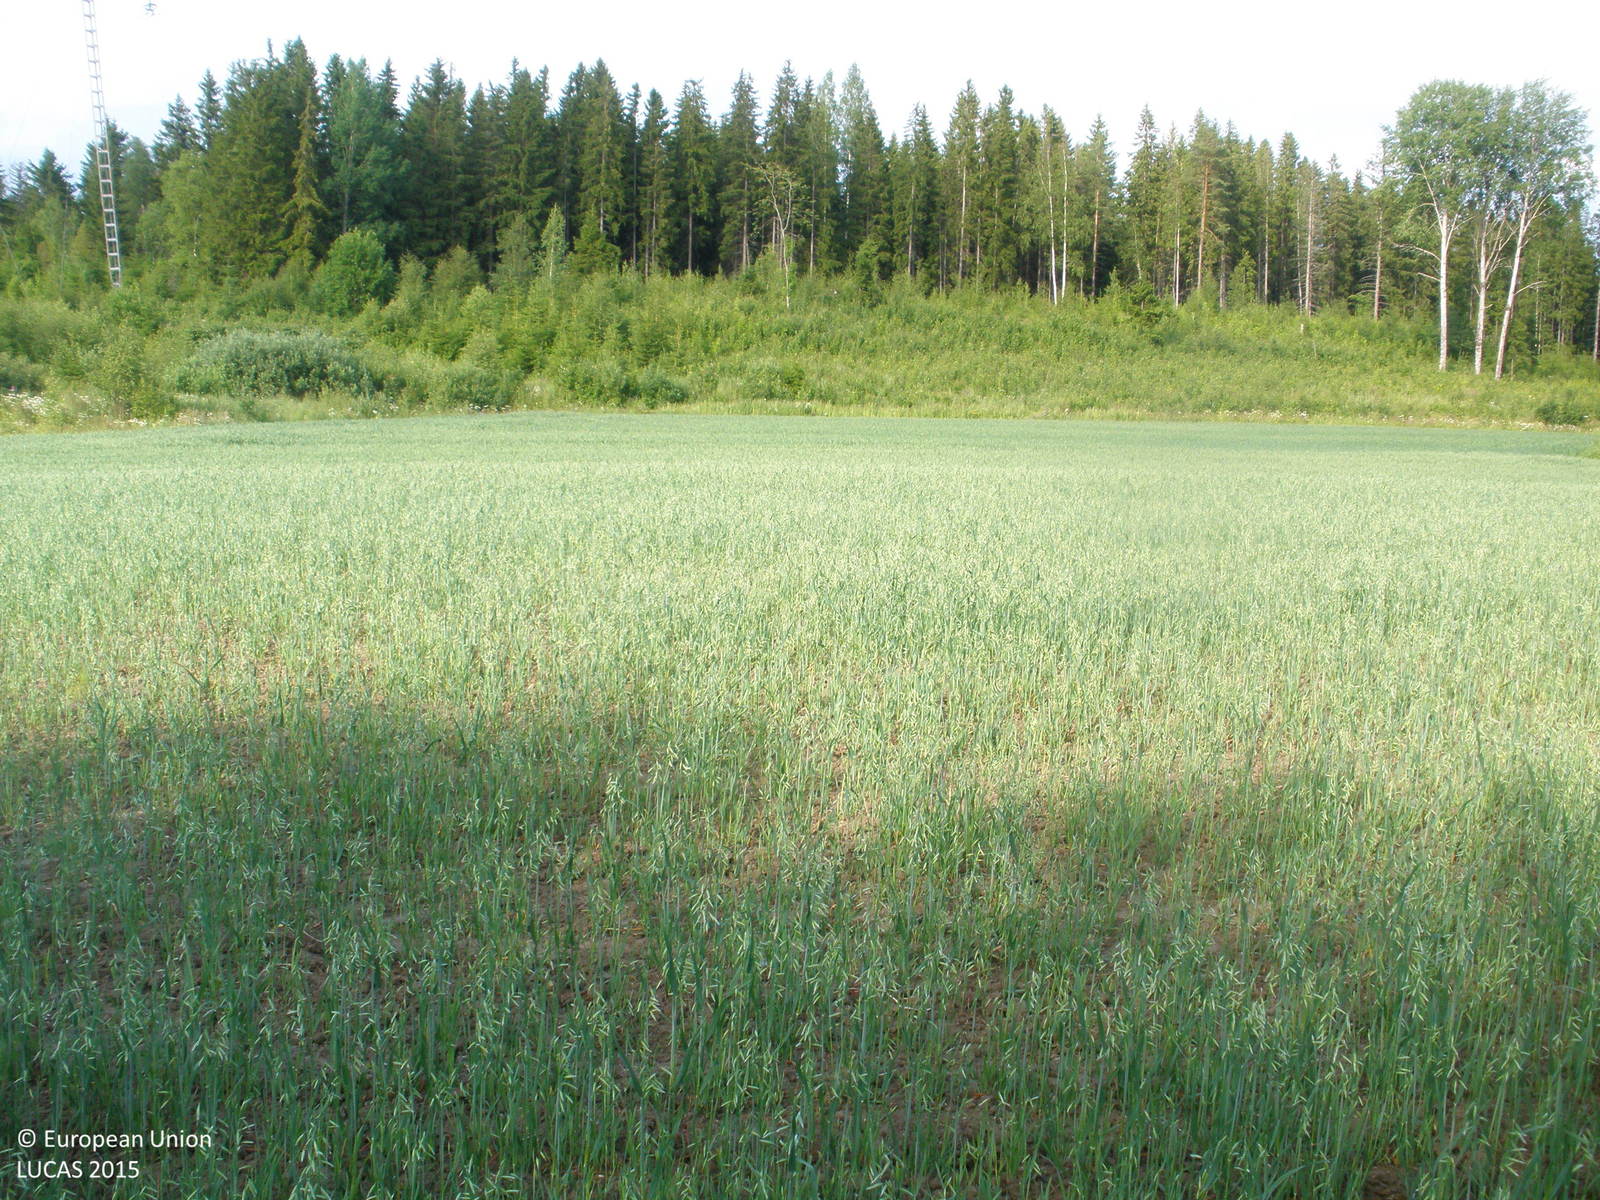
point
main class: Cropland
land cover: Oats
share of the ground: 50 - 75 %
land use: Agriculture (excluding fallow land and kitchen gardens)
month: July
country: FI
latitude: 61.4238
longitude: 23.9757
